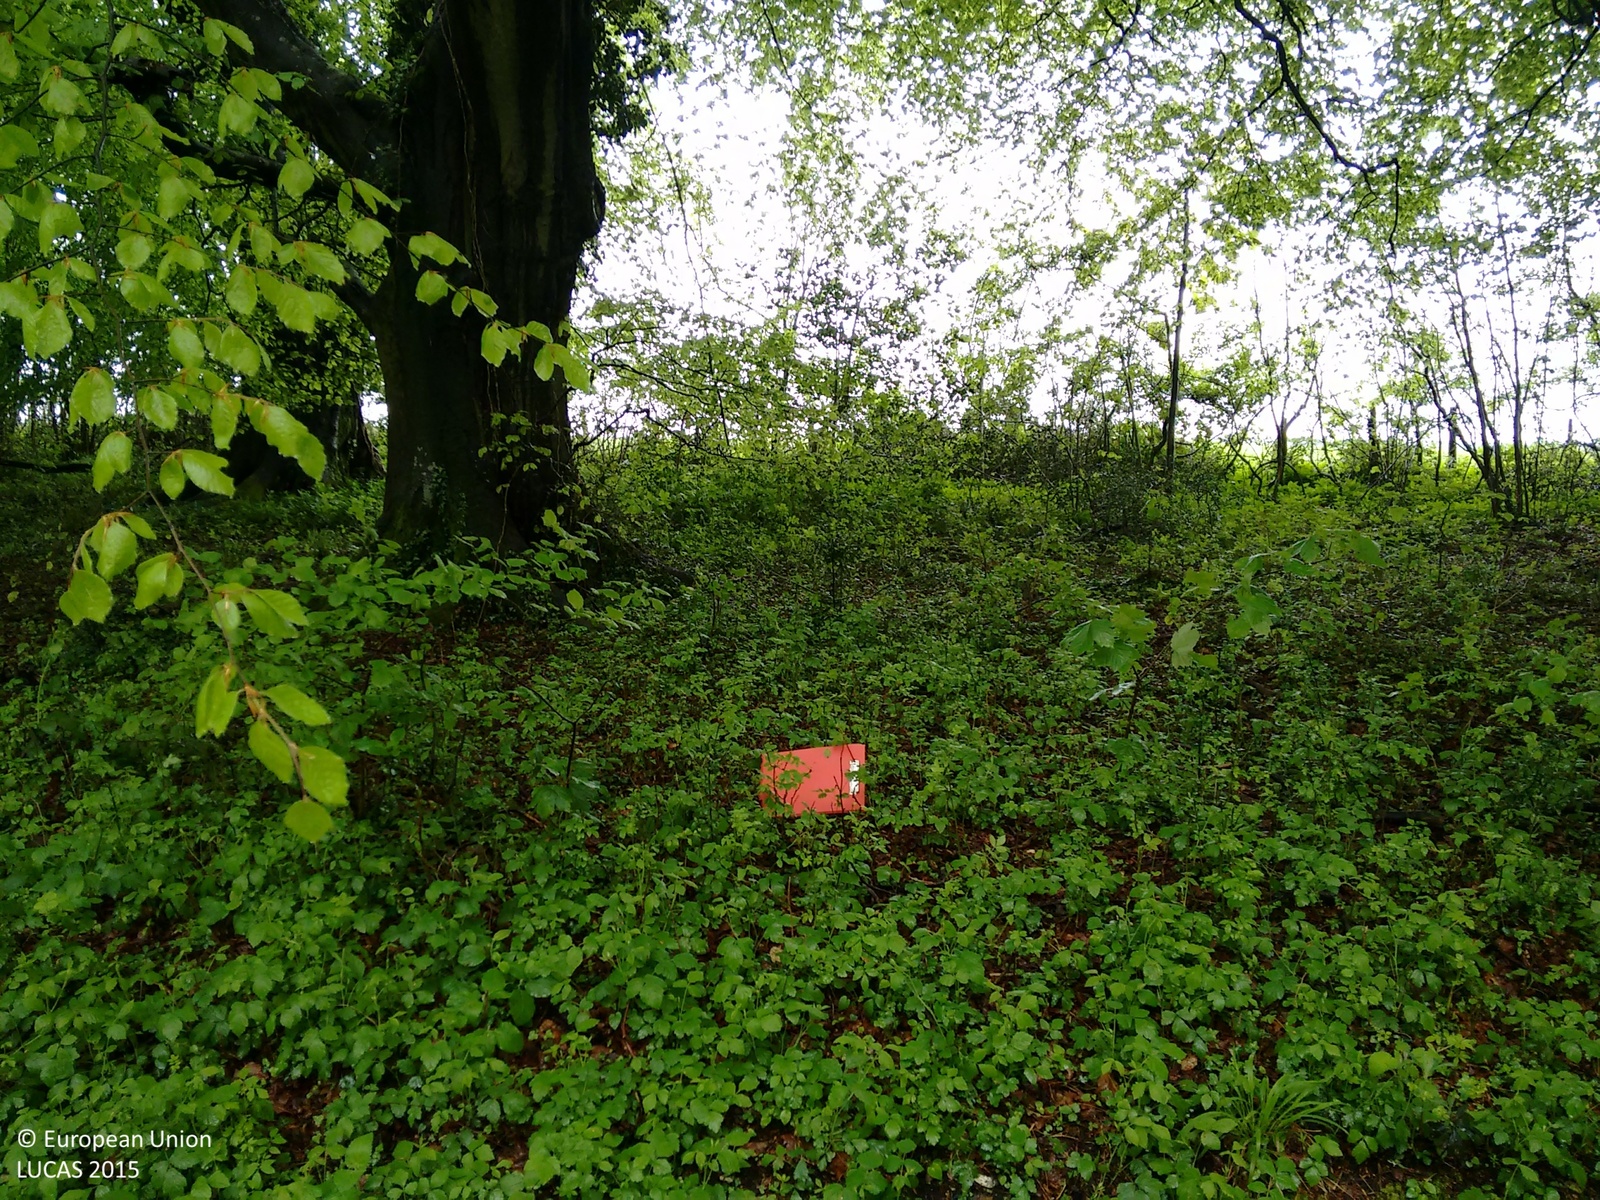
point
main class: Woodland
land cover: Broadleaved woodland
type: beech forest
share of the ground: > 75 %
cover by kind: broadleaved forest trees 100 %
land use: Semi-natural and natural areas not in use
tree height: > 5 m
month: May
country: GB
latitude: 50.9632
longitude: -0.9359
